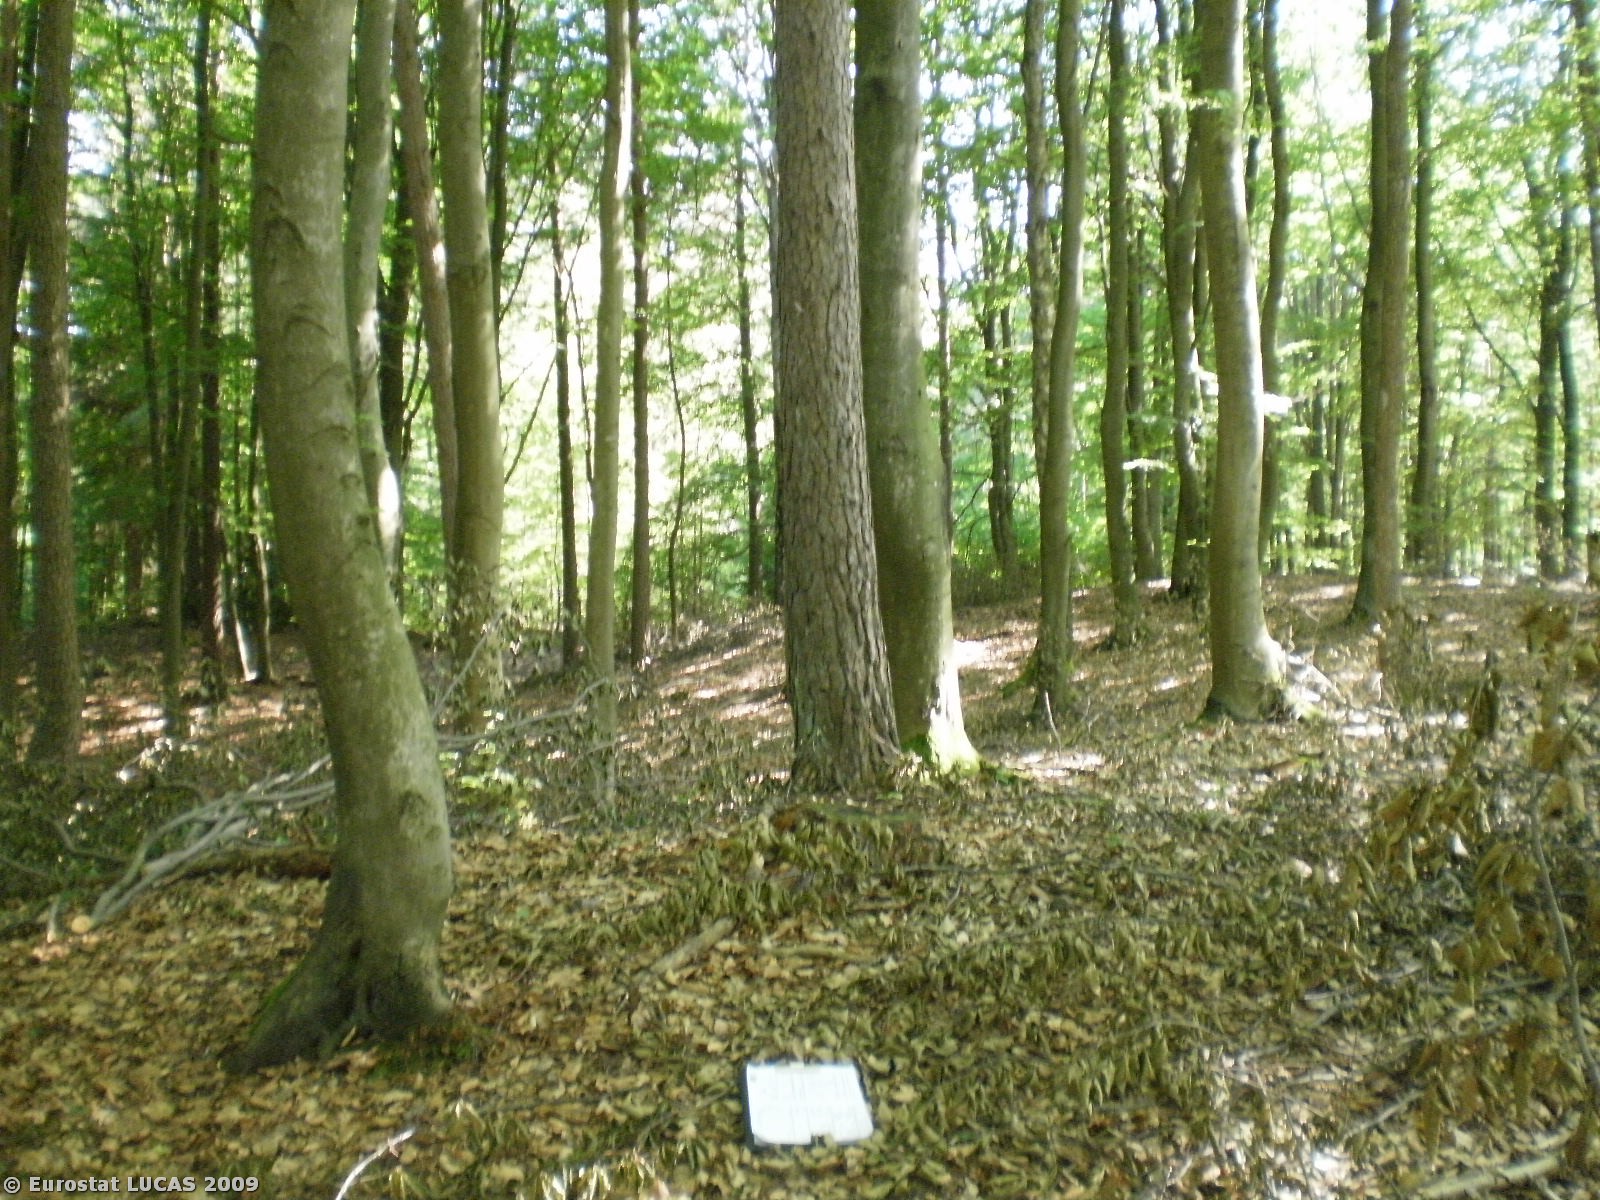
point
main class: Woodland
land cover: Mixed woodland
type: hemiboreal forest and nemoral coniferous forest and mixed broadleaved-coniferous forest
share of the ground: > 75 %
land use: Forestry
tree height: > 5 m
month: July
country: PL
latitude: 54.1055
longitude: 17.2439
